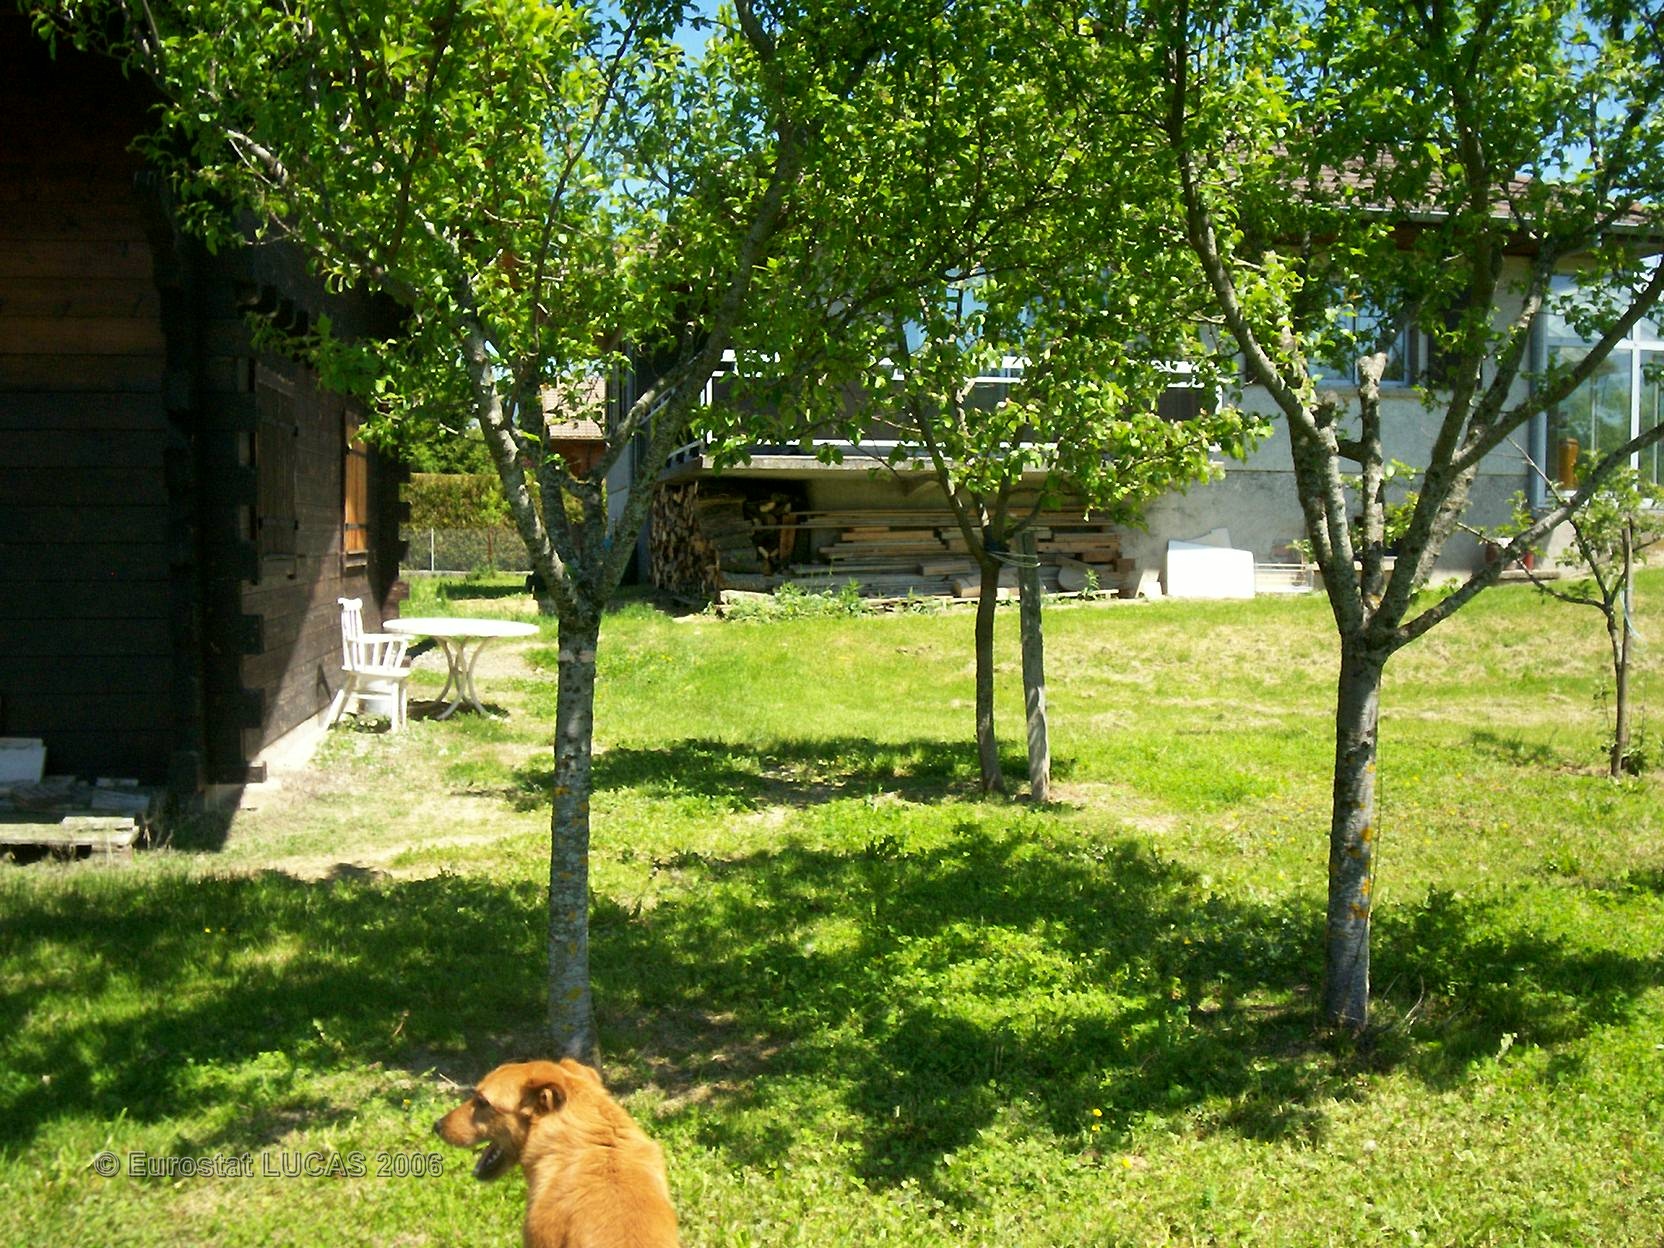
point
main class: Grassland
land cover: Grassland with sparse tree/shrub cover
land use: Residential
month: June
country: FR
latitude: 46.3516
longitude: 6.6115
